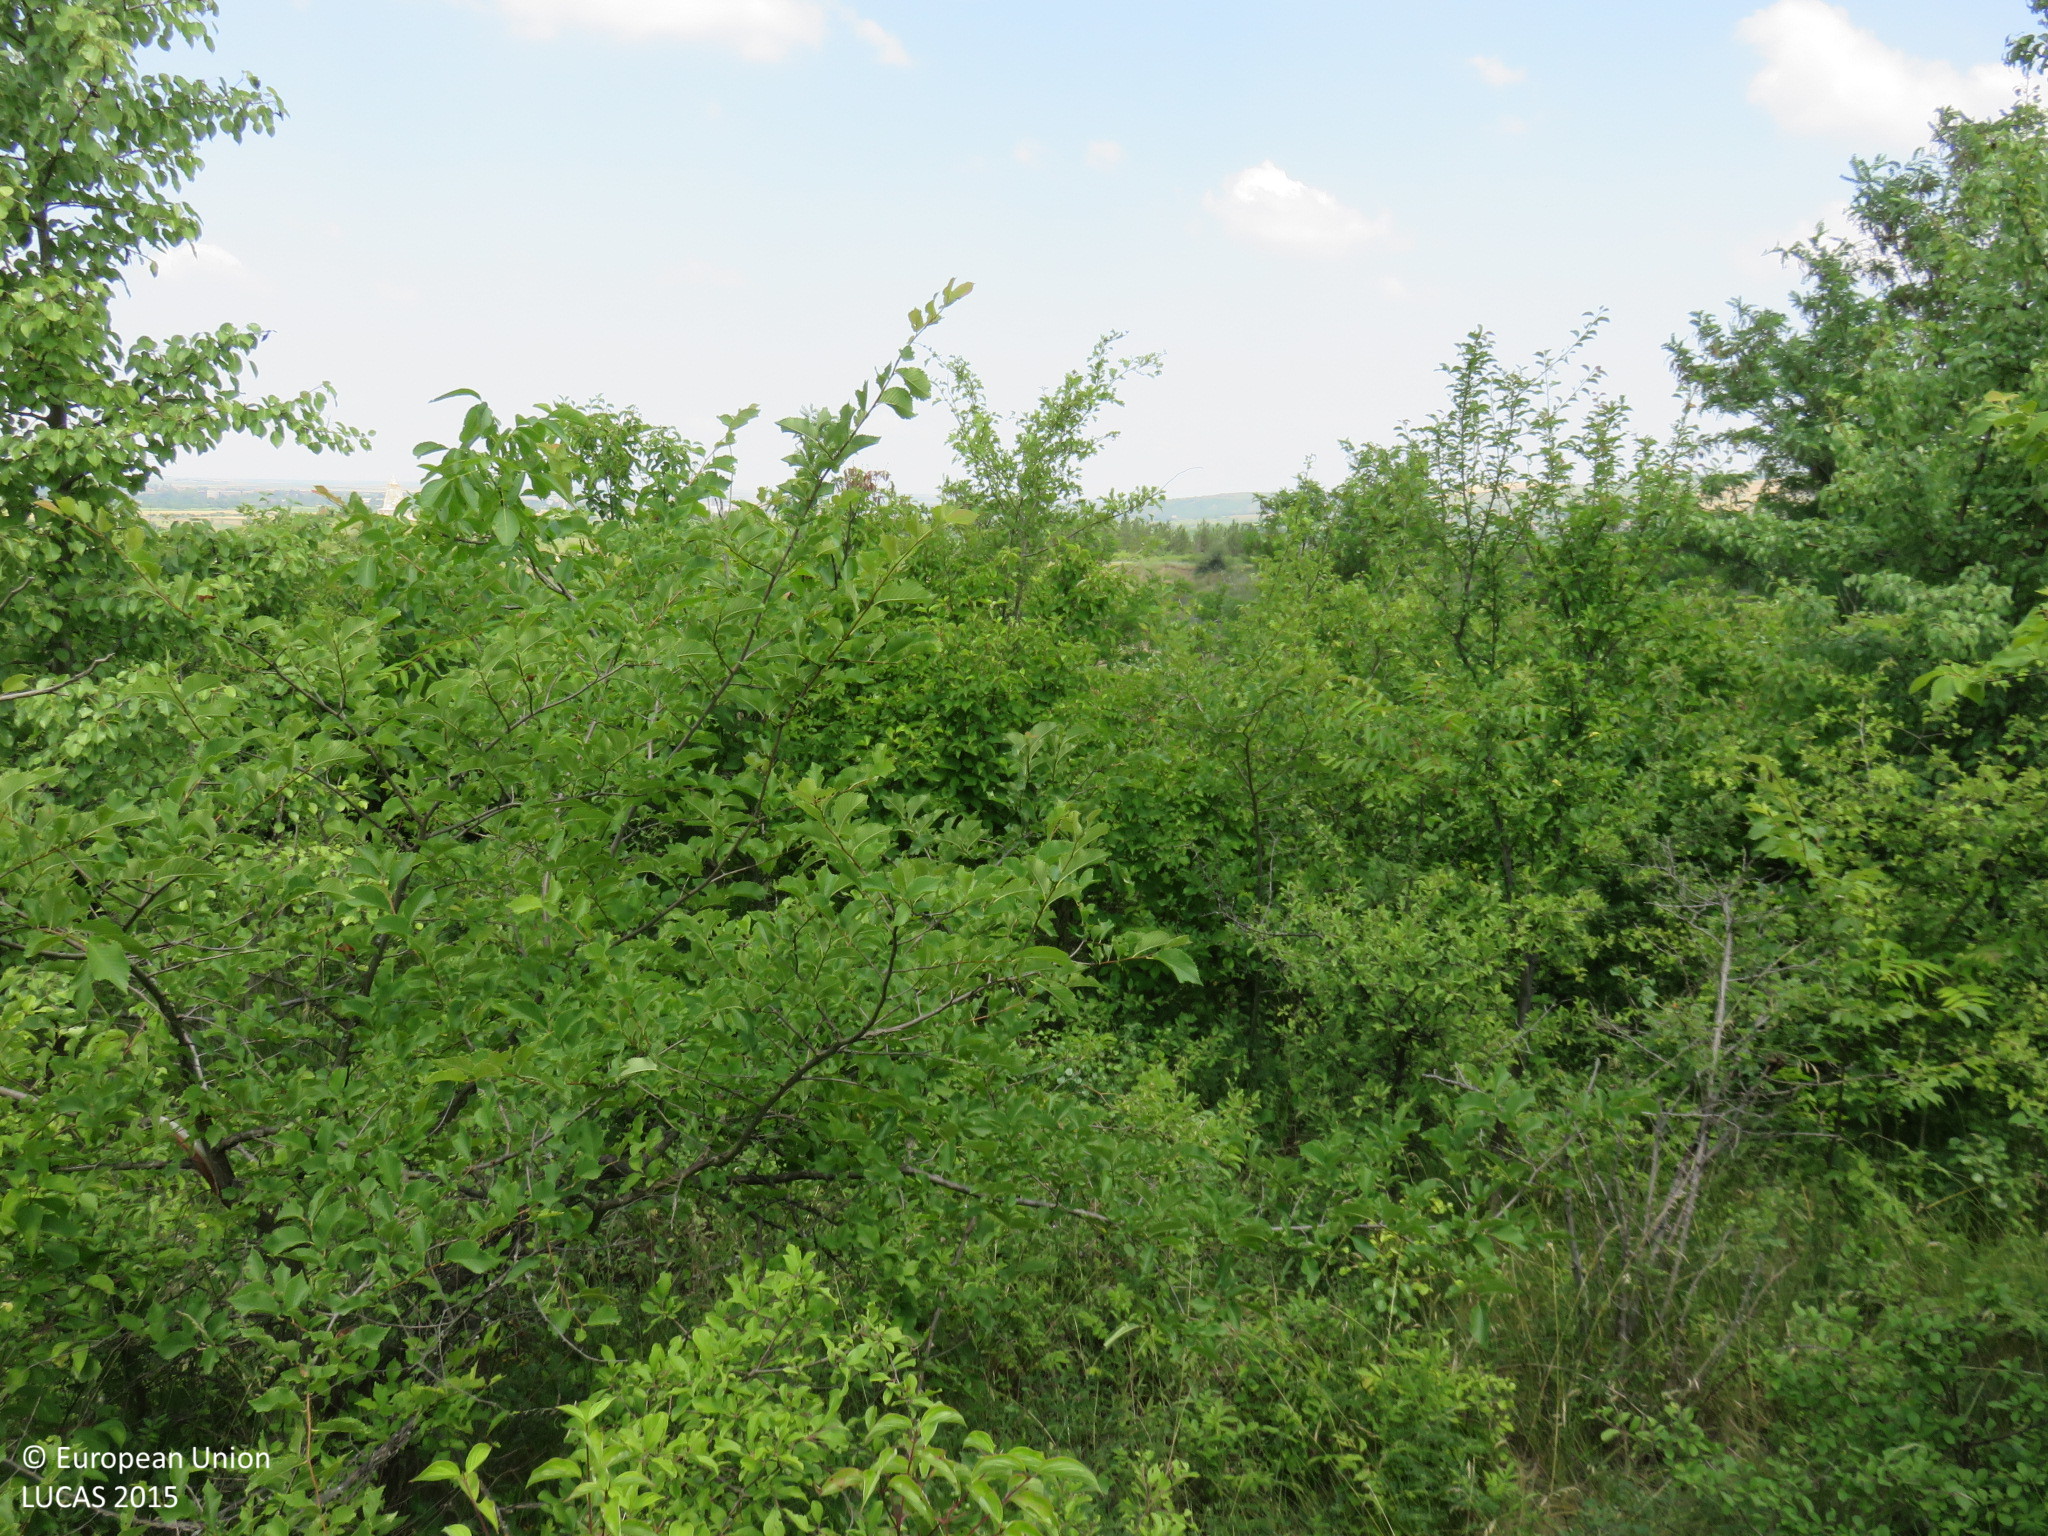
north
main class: Shrubland
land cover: Shrubland with sparse tree cover
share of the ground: > 75 %
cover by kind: shrubs 95 %, broadleaved forest trees 5 %
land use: Fallow land
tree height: < 5 m
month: June
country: BG
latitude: 43.4282
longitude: 24.5517
